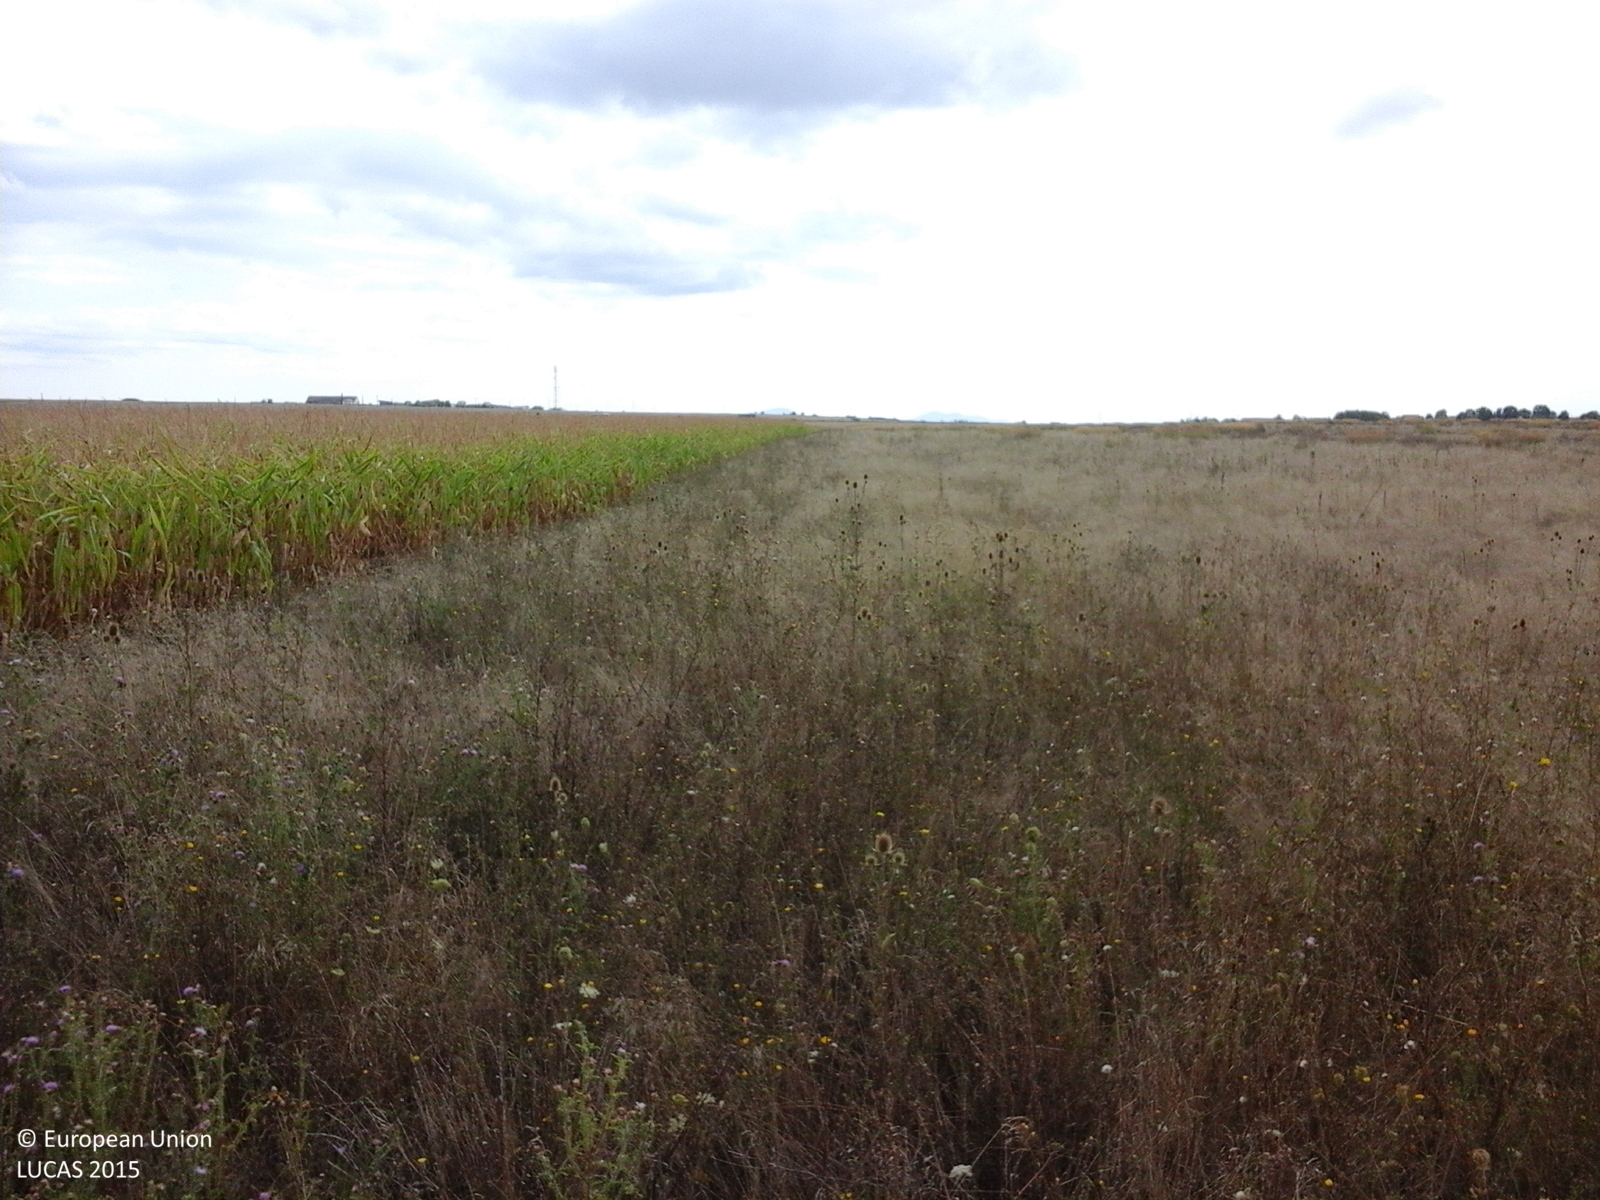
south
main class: Cropland
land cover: Maize
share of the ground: > 75 %
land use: Agriculture (excluding fallow land and kitchen gardens)
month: August
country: RO
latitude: 45.4173
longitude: 21.5203
